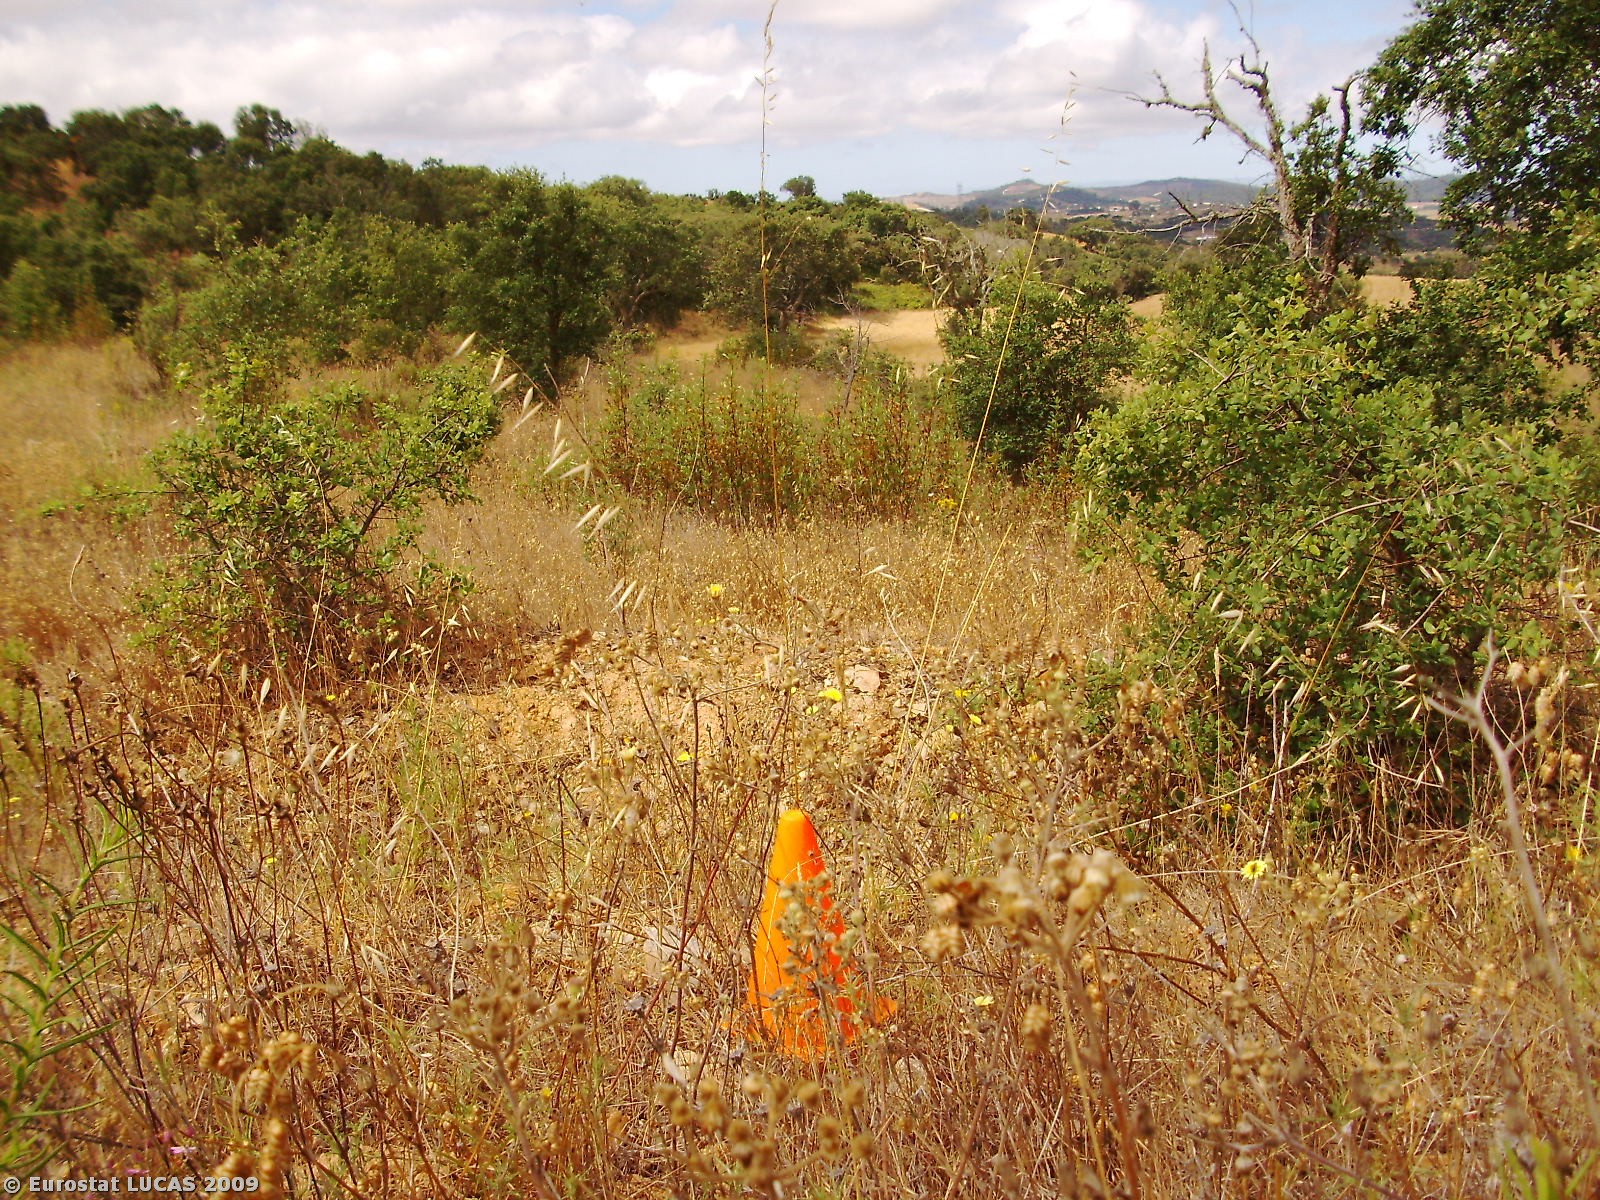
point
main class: Woodland
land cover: Broadleaved woodland
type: broadleaved evergreen forest
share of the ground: 10 - 25 %
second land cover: Shrubland with sparse tree cover
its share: 25 - 50 %
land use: Forestry
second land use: Fallow land
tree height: > 5 m
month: June
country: PT
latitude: 37.8327
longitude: -8.6431
